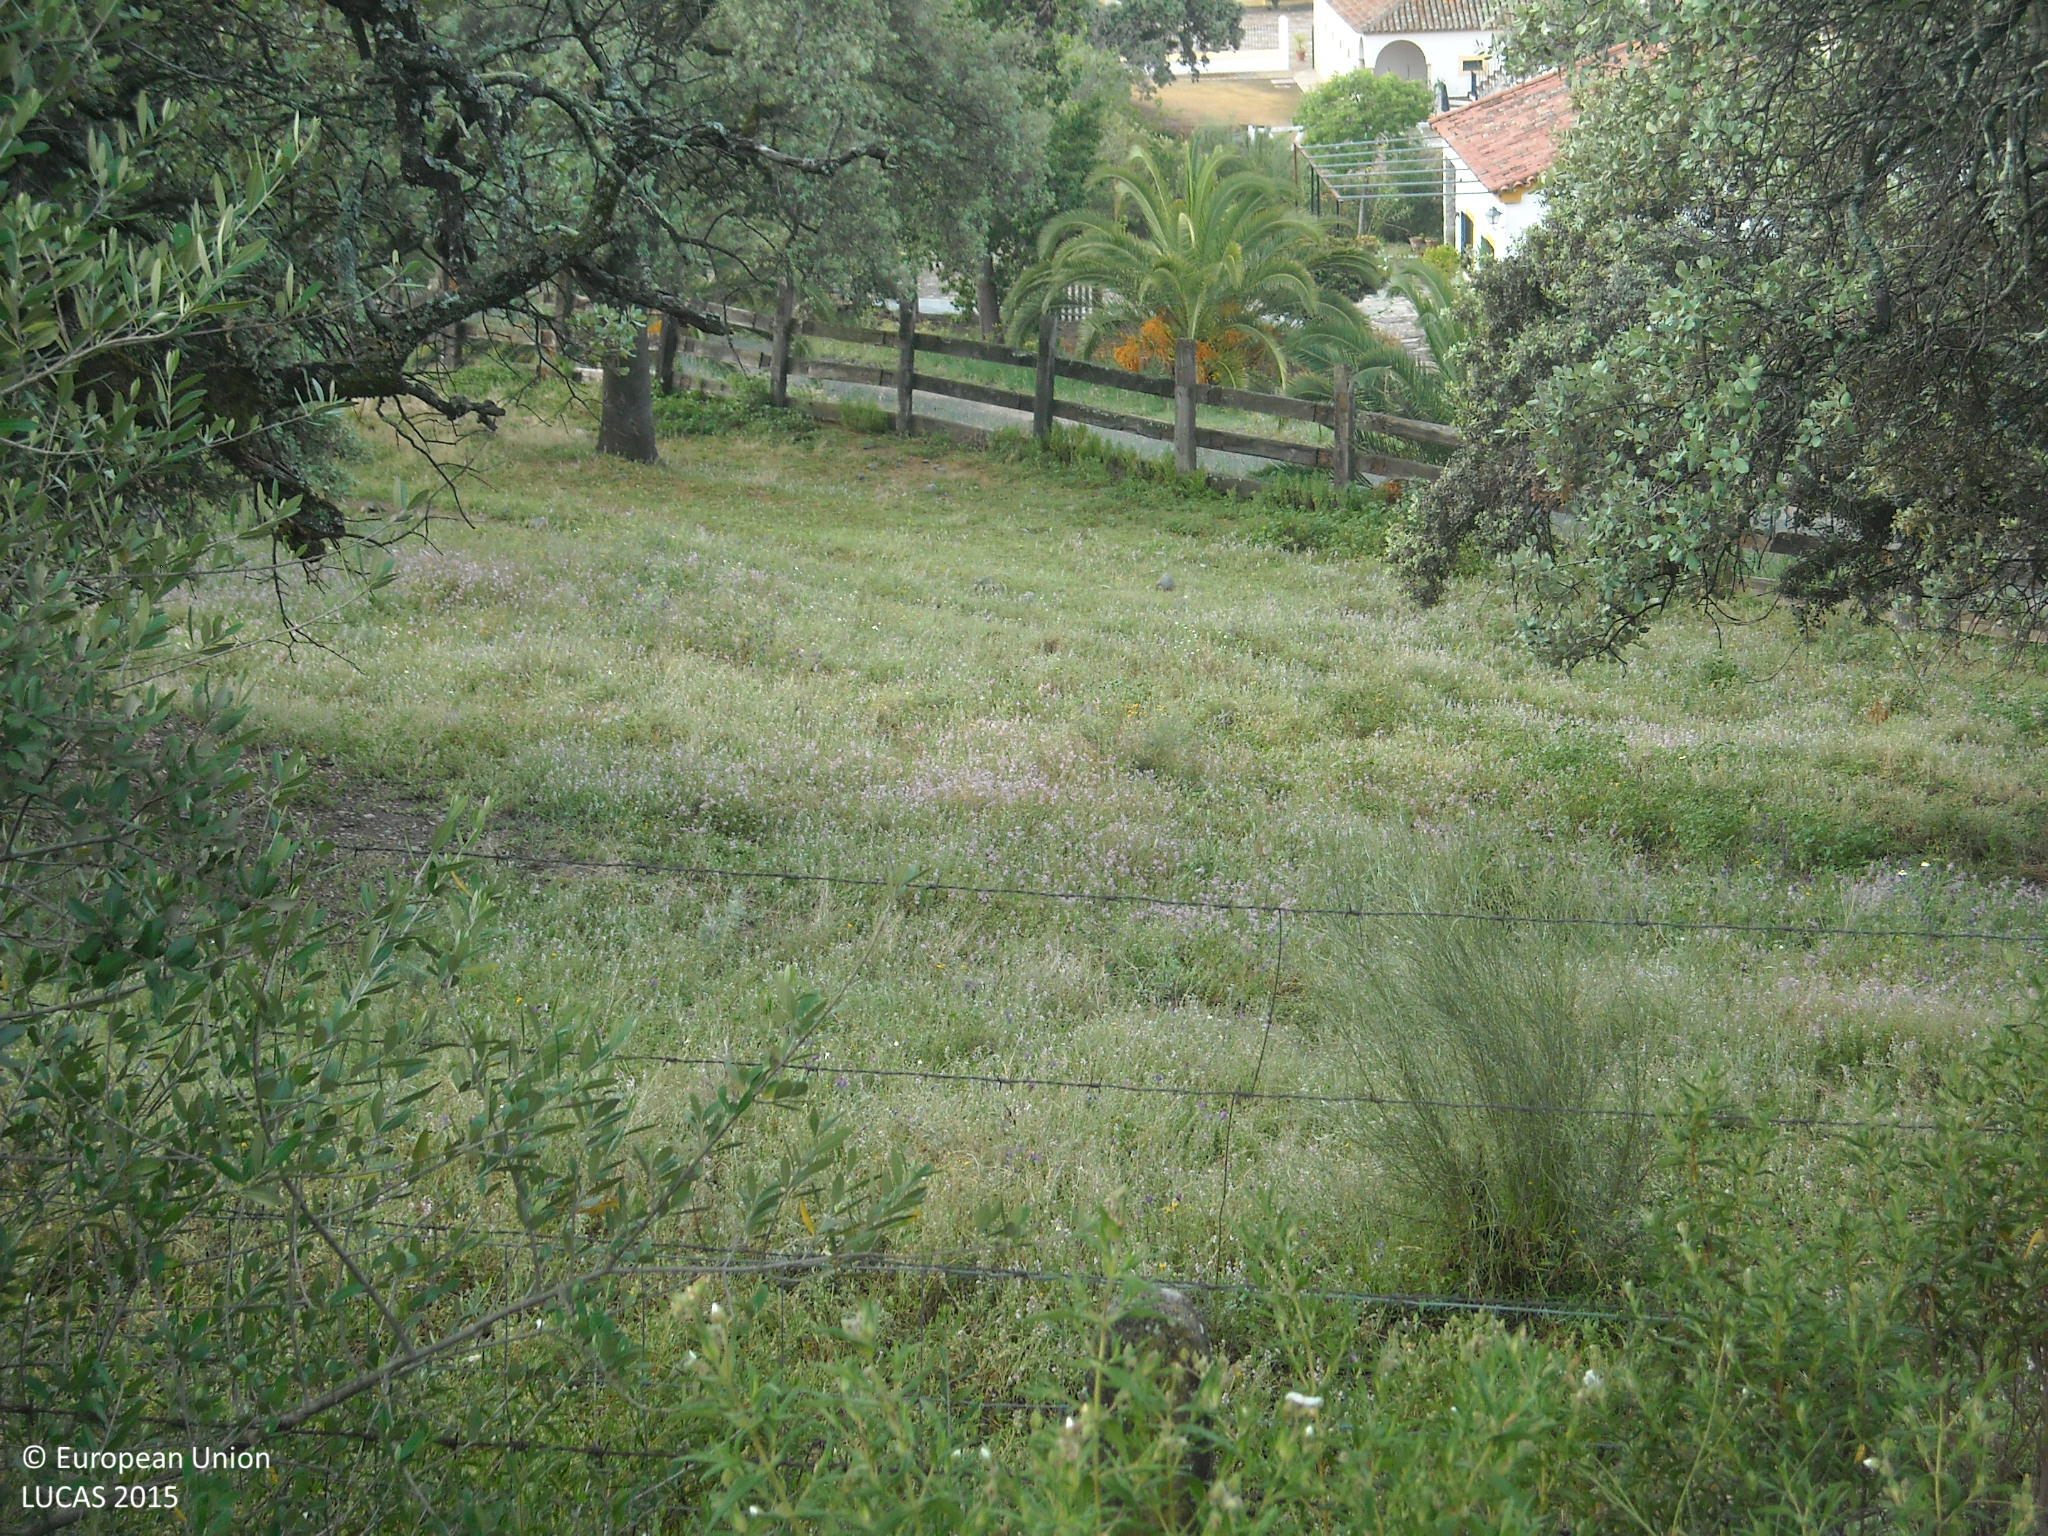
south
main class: Woodland
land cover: Broadleaved woodland
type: broadleaved evergreen forest
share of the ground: 10 - 25 %
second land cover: Grassland without tree/shrub cover
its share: > 75 %
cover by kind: herbaceous plants 70 %, broadleaved forest trees 20 %, shrubs 10 %
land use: Forestry
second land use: Agriculture (excluding fallow land and kitchen gardens)
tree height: > 5 m
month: April
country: ES
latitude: 37.7059
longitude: -6.2428
